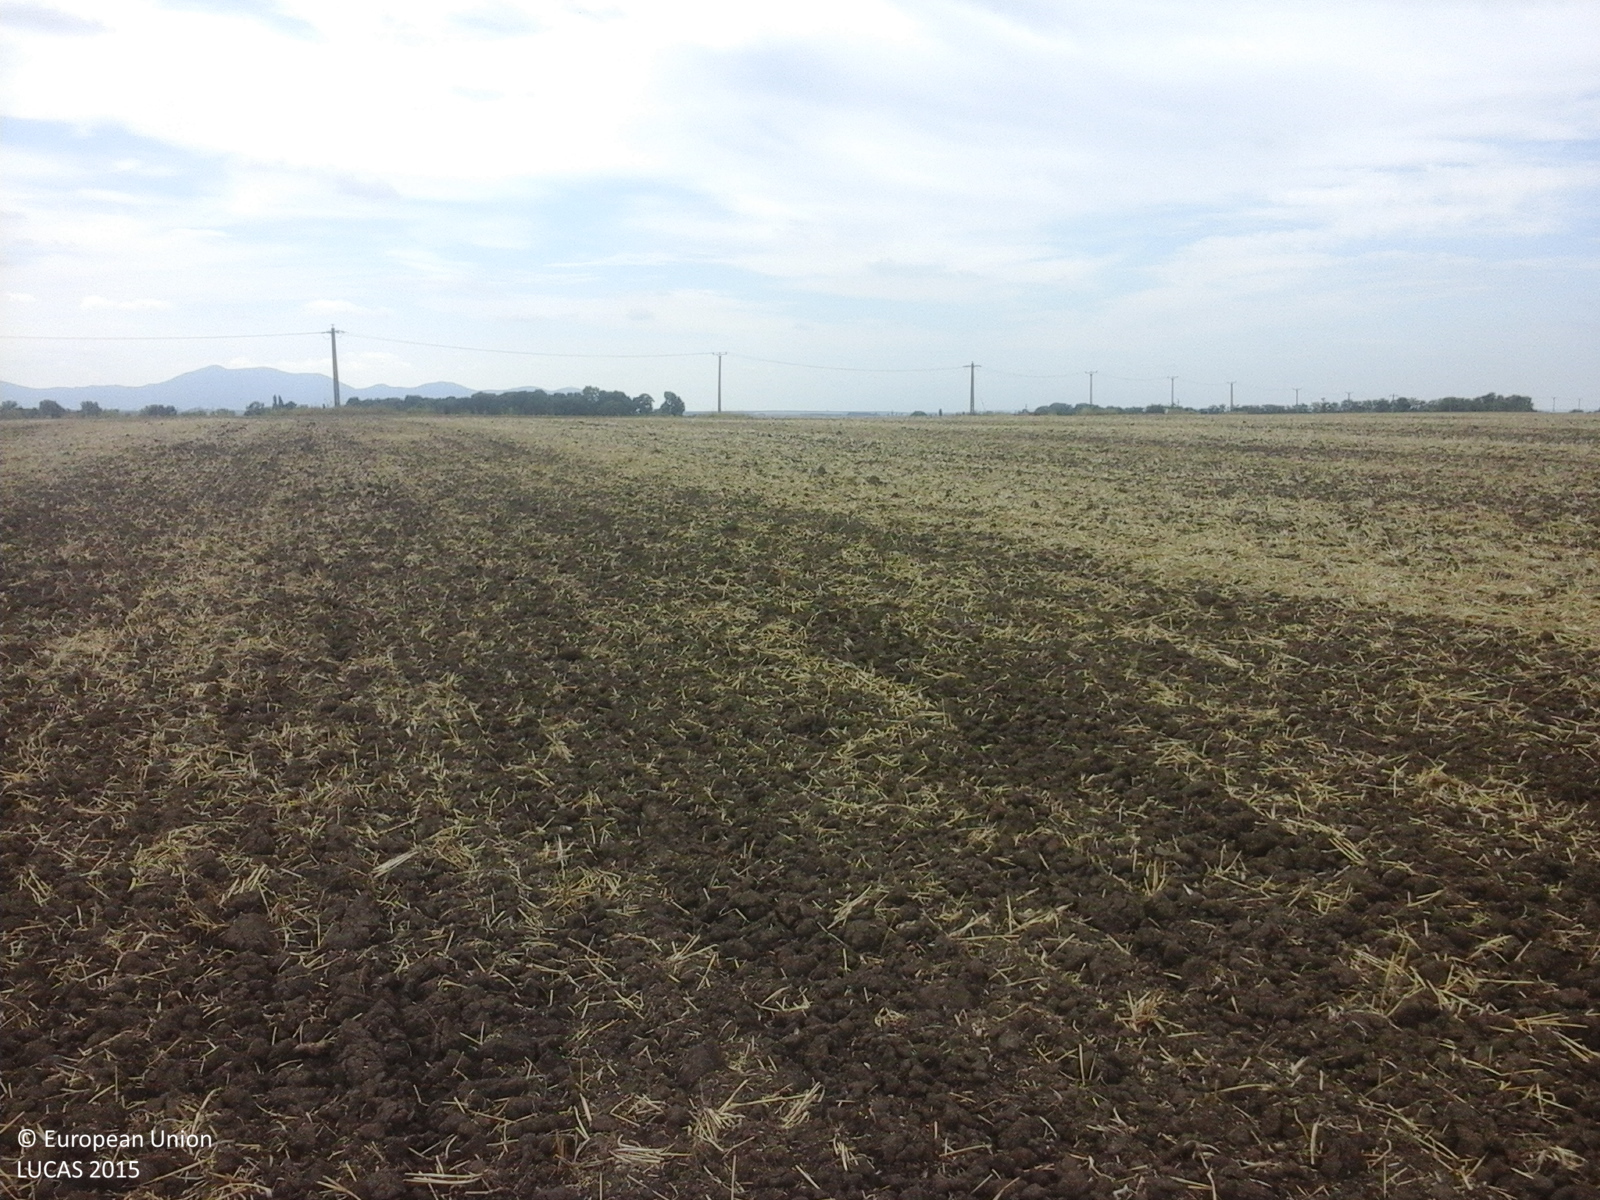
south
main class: Cropland
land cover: Common wheat
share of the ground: < 10 %
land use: Agriculture (excluding fallow land and kitchen gardens)
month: August
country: RO
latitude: 45.2970
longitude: 21.2885
